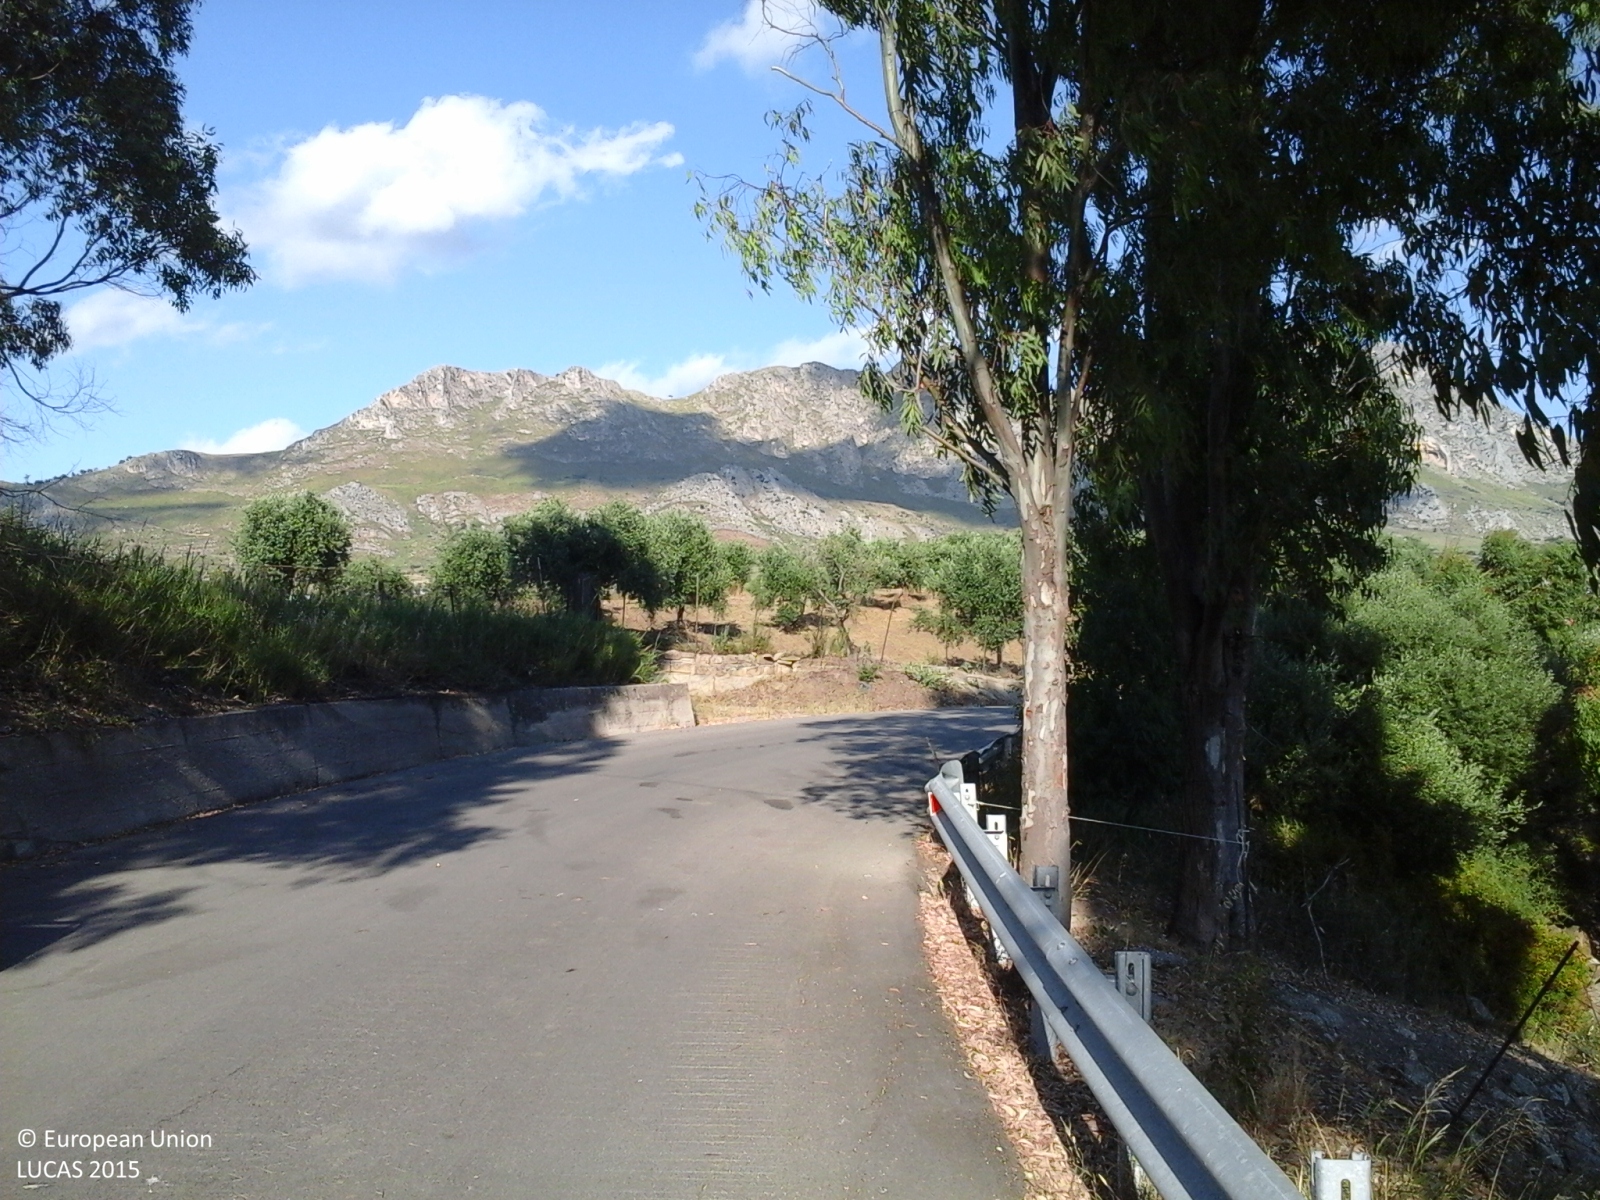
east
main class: Cropland
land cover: Olive groves
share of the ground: 50 - 75 %
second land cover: Other bare soil
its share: > 75 %
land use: Agriculture (excluding fallow land and kitchen gardens)
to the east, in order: Olive groves; Other bare soil; Ditches and canals; Olive groves; Grassland without tree/shrub cover; Fences; Lines of trees; Paved roads, cycling and walking lanes; Grass margins; Fences; Olive groves; Fences; Permanent crops (only in case pi); Arable land (only in case pi)
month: June
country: IT
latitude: 37.9913
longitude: 13.5163
